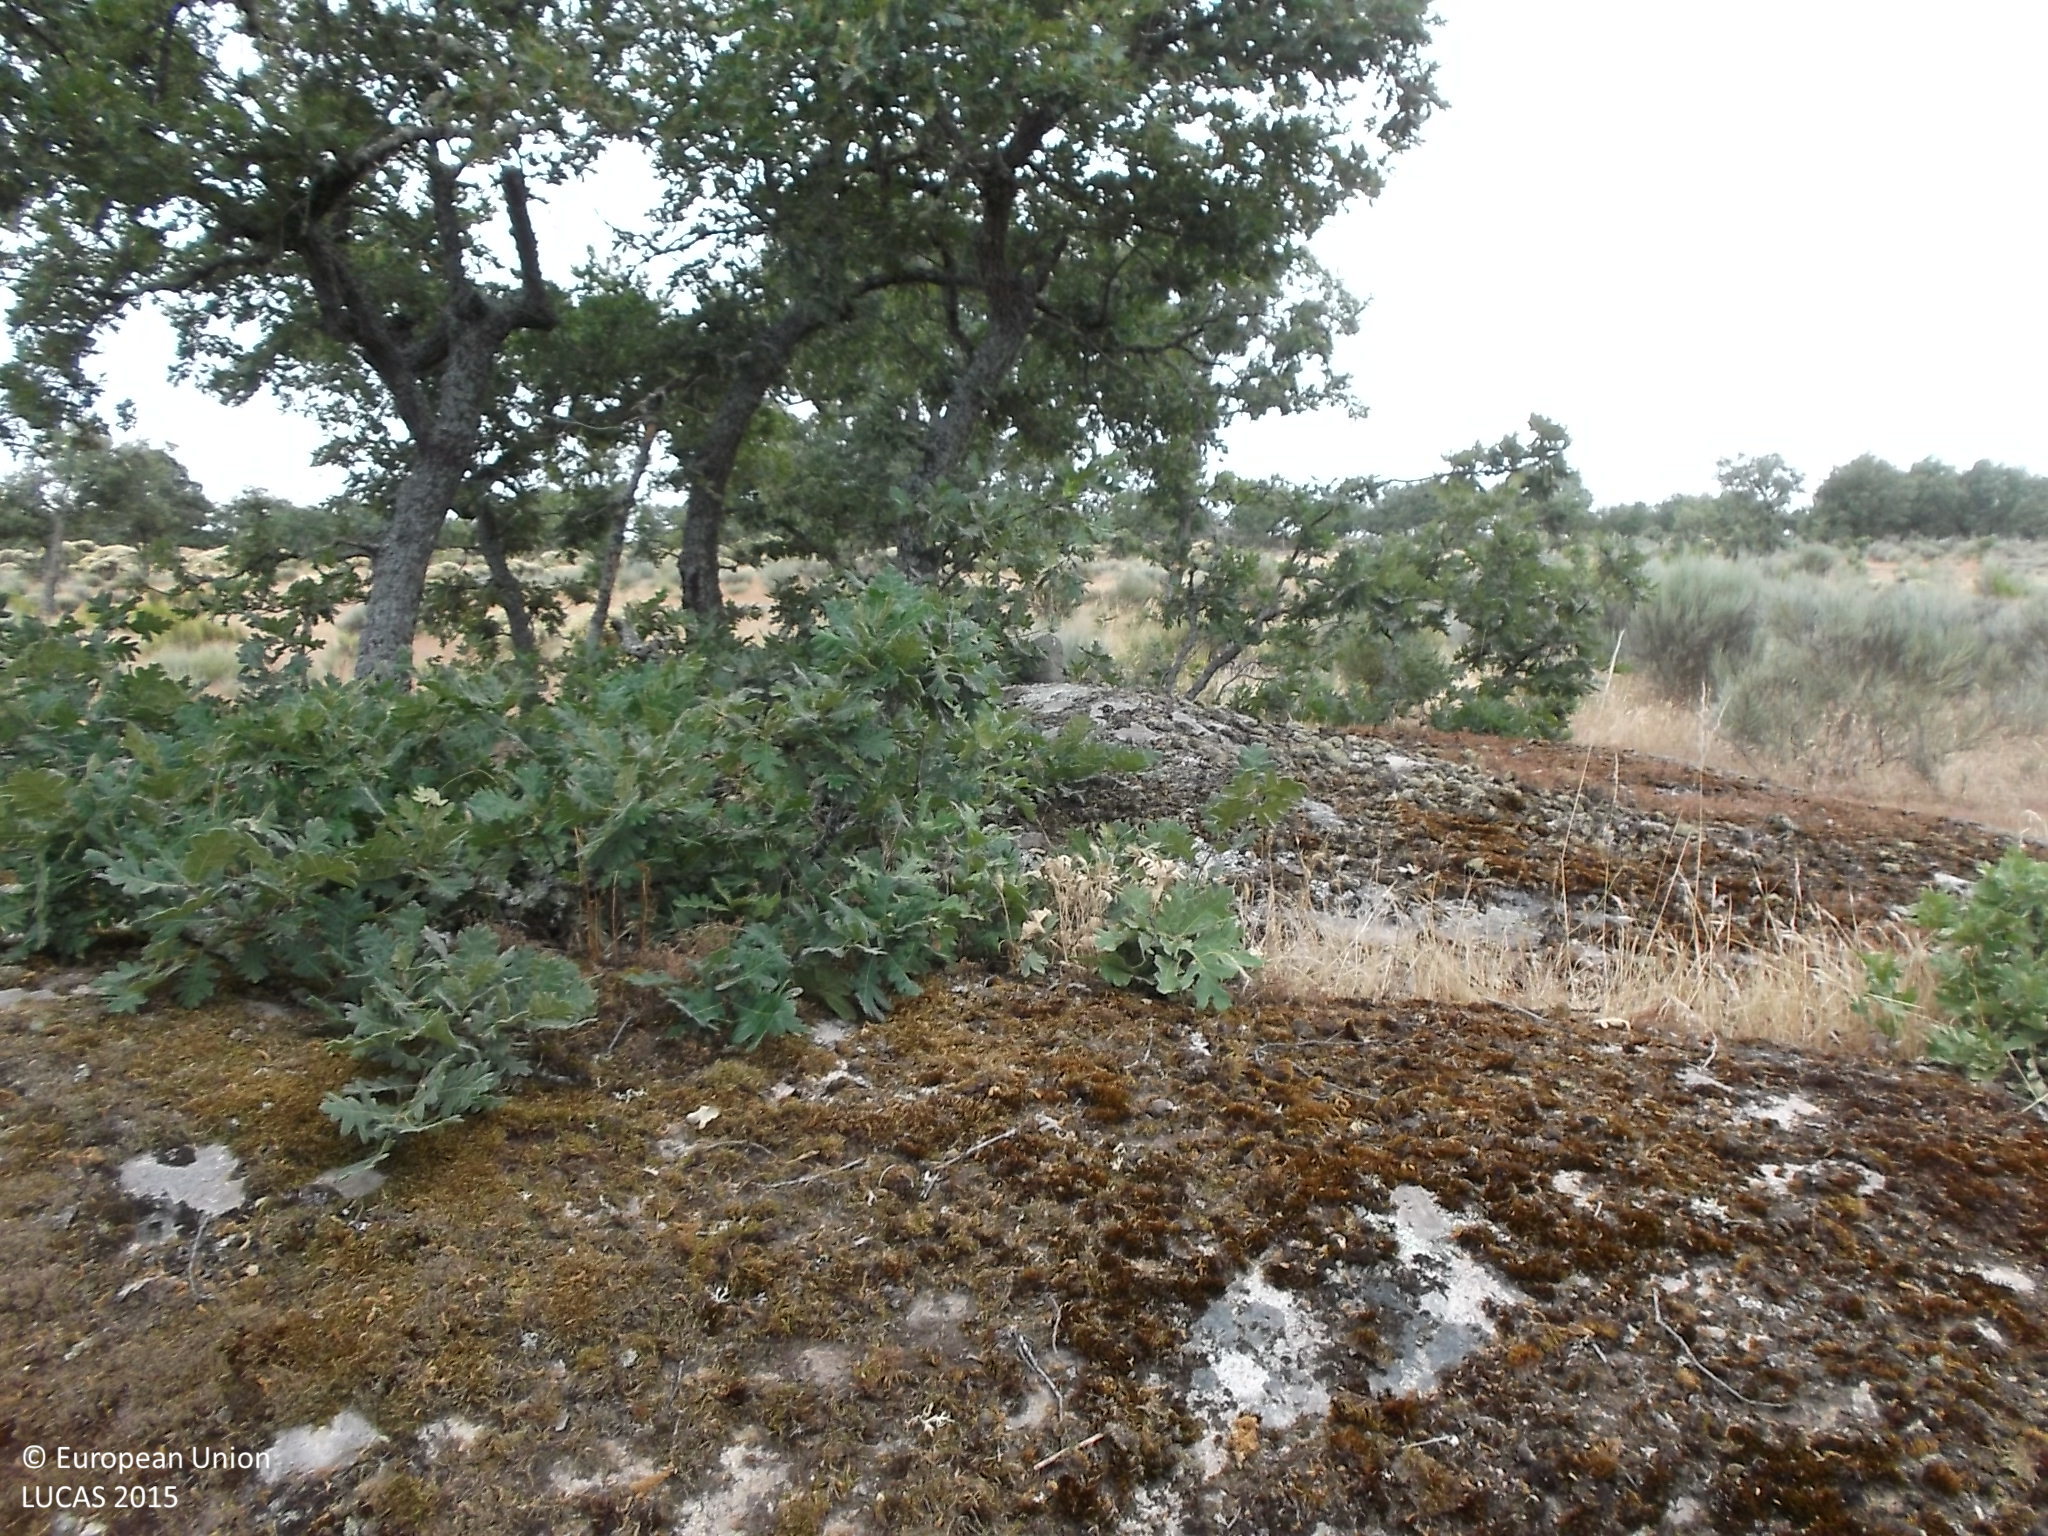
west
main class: Woodland
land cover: Broadleaved woodland
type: broadleaved evergreen forest
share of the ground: 25 - 50 %
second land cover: Grassland without tree/shrub cover
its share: 25 - 50 %
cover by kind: broadleaved forest trees 40 %, herbaceous plants 40 %, shrubs 20 %
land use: Forestry
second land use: Agriculture (excluding fallow land and kitchen gardens)
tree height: < 5 m
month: July
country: ES
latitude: 41.2007
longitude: -6.3727
